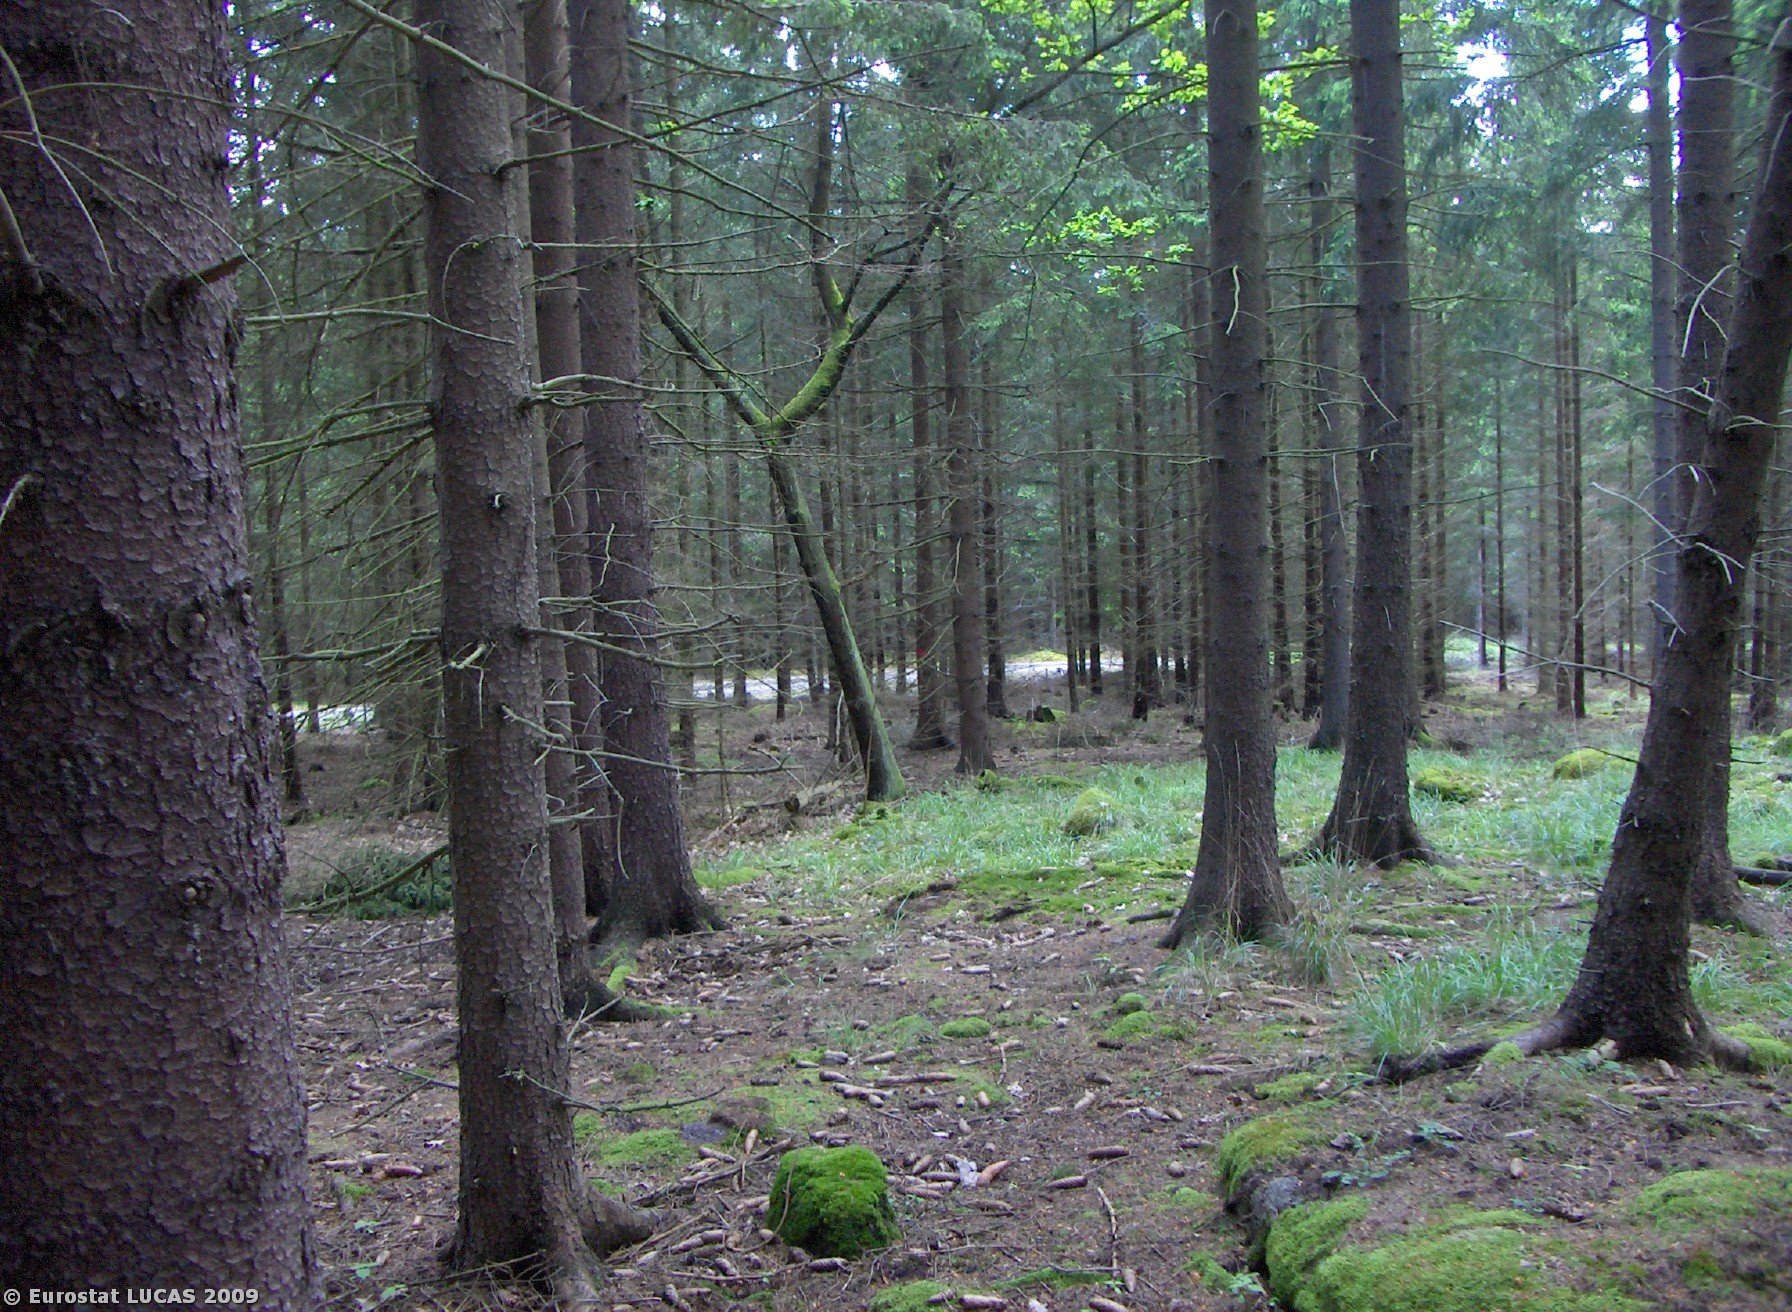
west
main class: Woodland
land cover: Coniferous woodland
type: hemiboreal forest and nemoral coniferous forest and mixed broadleaved-coniferous forest
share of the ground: > 75 %
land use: Forestry
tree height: > 5 m
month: May
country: CZ
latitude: 49.4762
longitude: 14.2104
